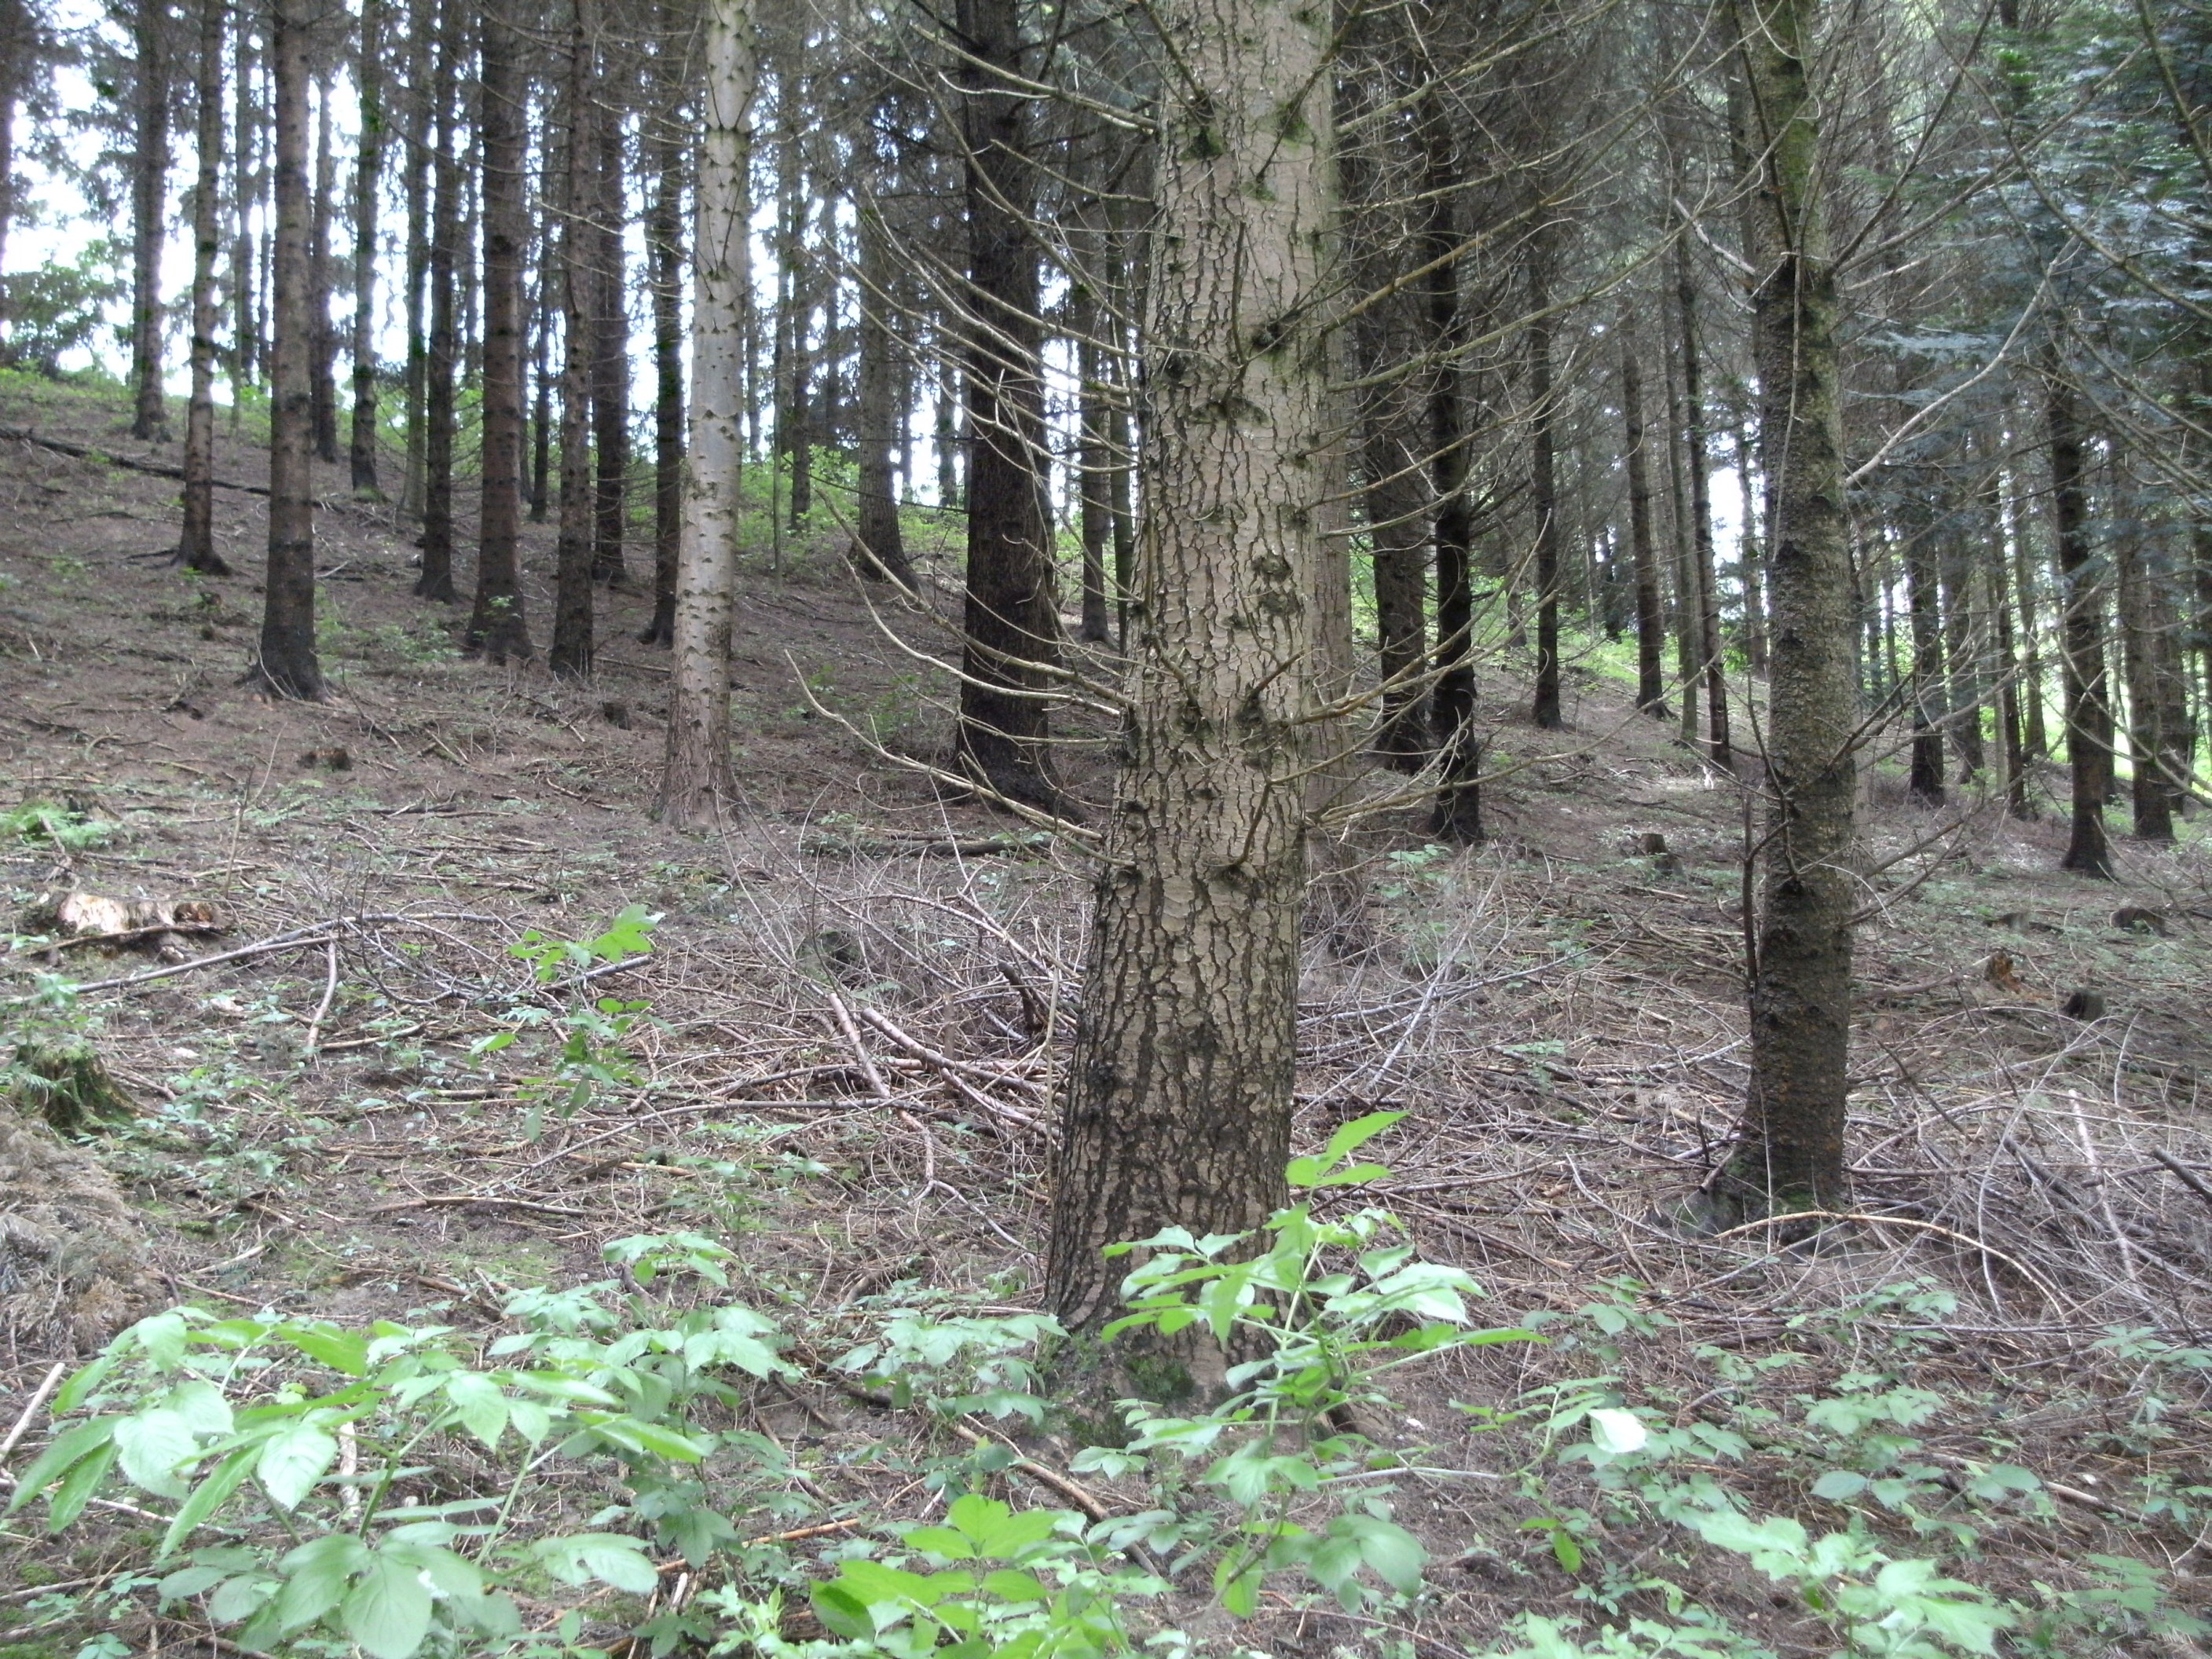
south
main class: Woodland
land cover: Other mixed woodland
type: hemiboreal forest and nemoral coniferous forest and mixed broadleaved-coniferous forest
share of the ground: > 75 %
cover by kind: coniferous forest trees 60 %, broadleaved forest trees 30 %, shrubs 5 %, herbaceous plants 5 %
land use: Forestry
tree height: > 5 m
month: May
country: AT
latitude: 48.1314
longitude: 14.0441
